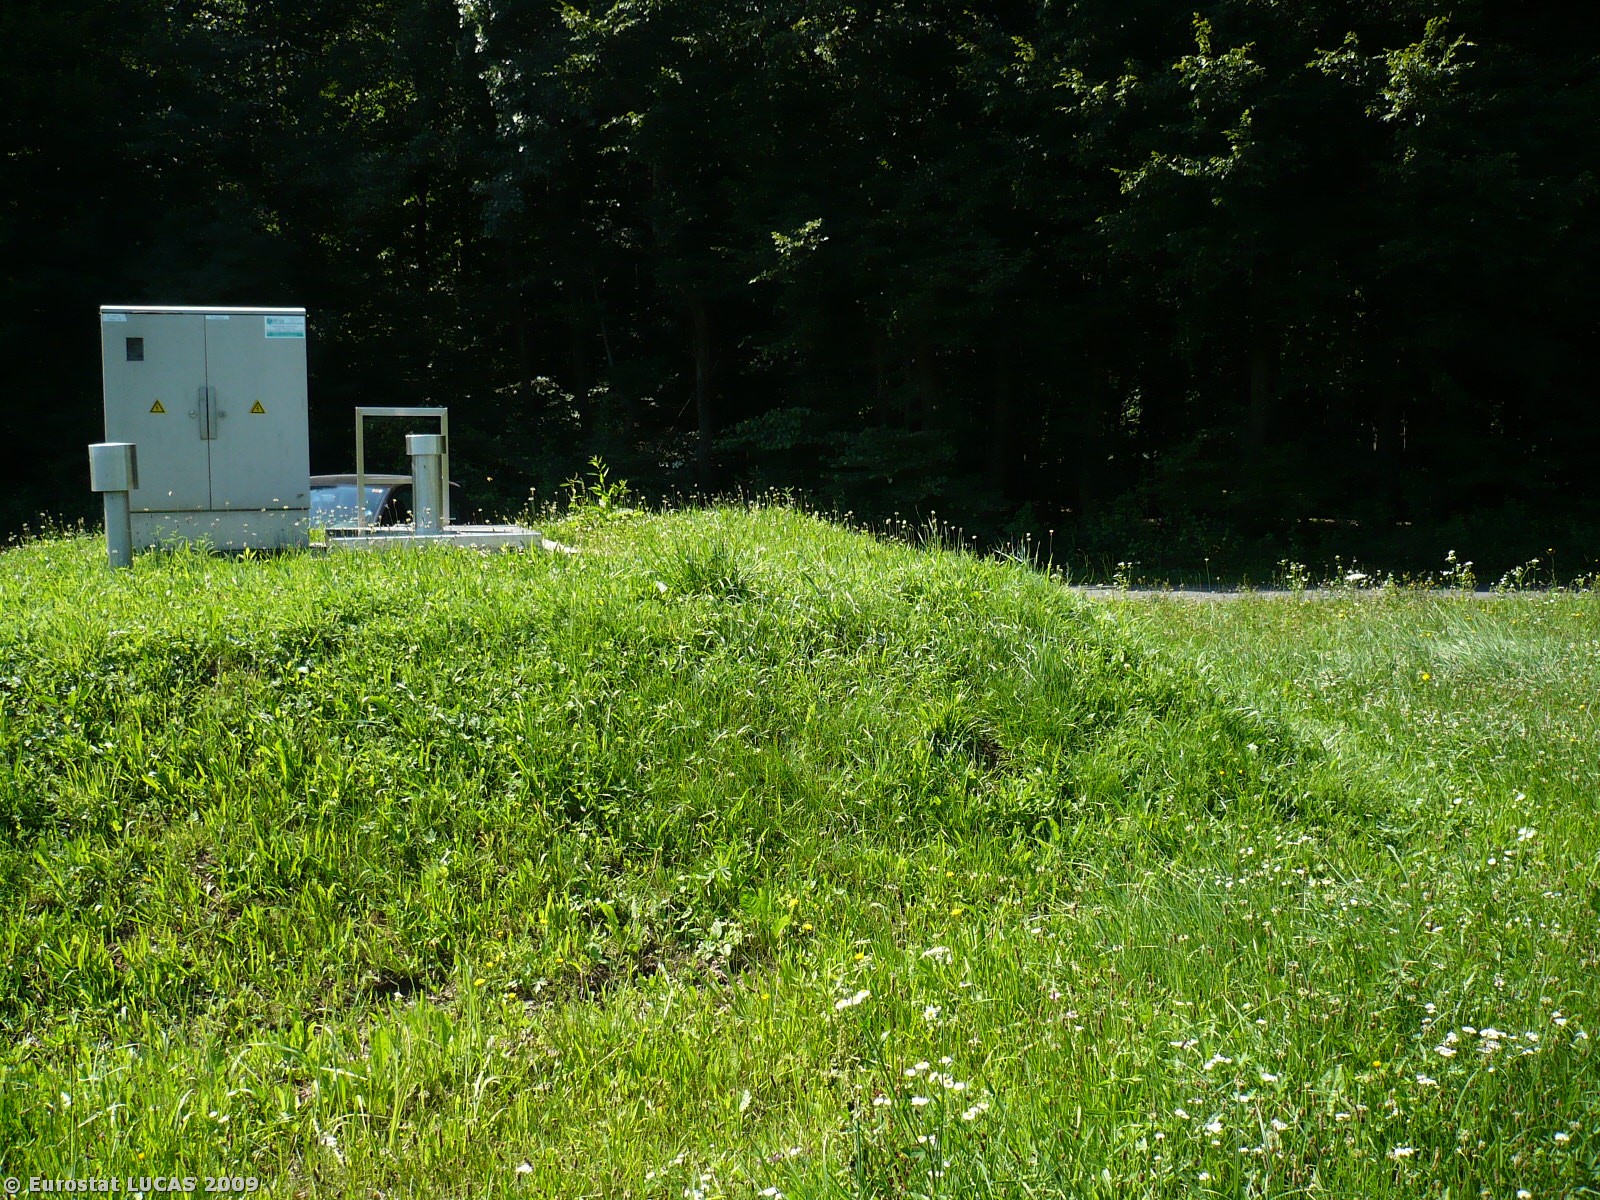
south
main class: Grassland
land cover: Grassland without tree/shrub cover
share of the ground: > 75 %
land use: Agriculture (excluding fallow land and kitchen gardens)
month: July
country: SI
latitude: 46.7392
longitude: 16.0601
